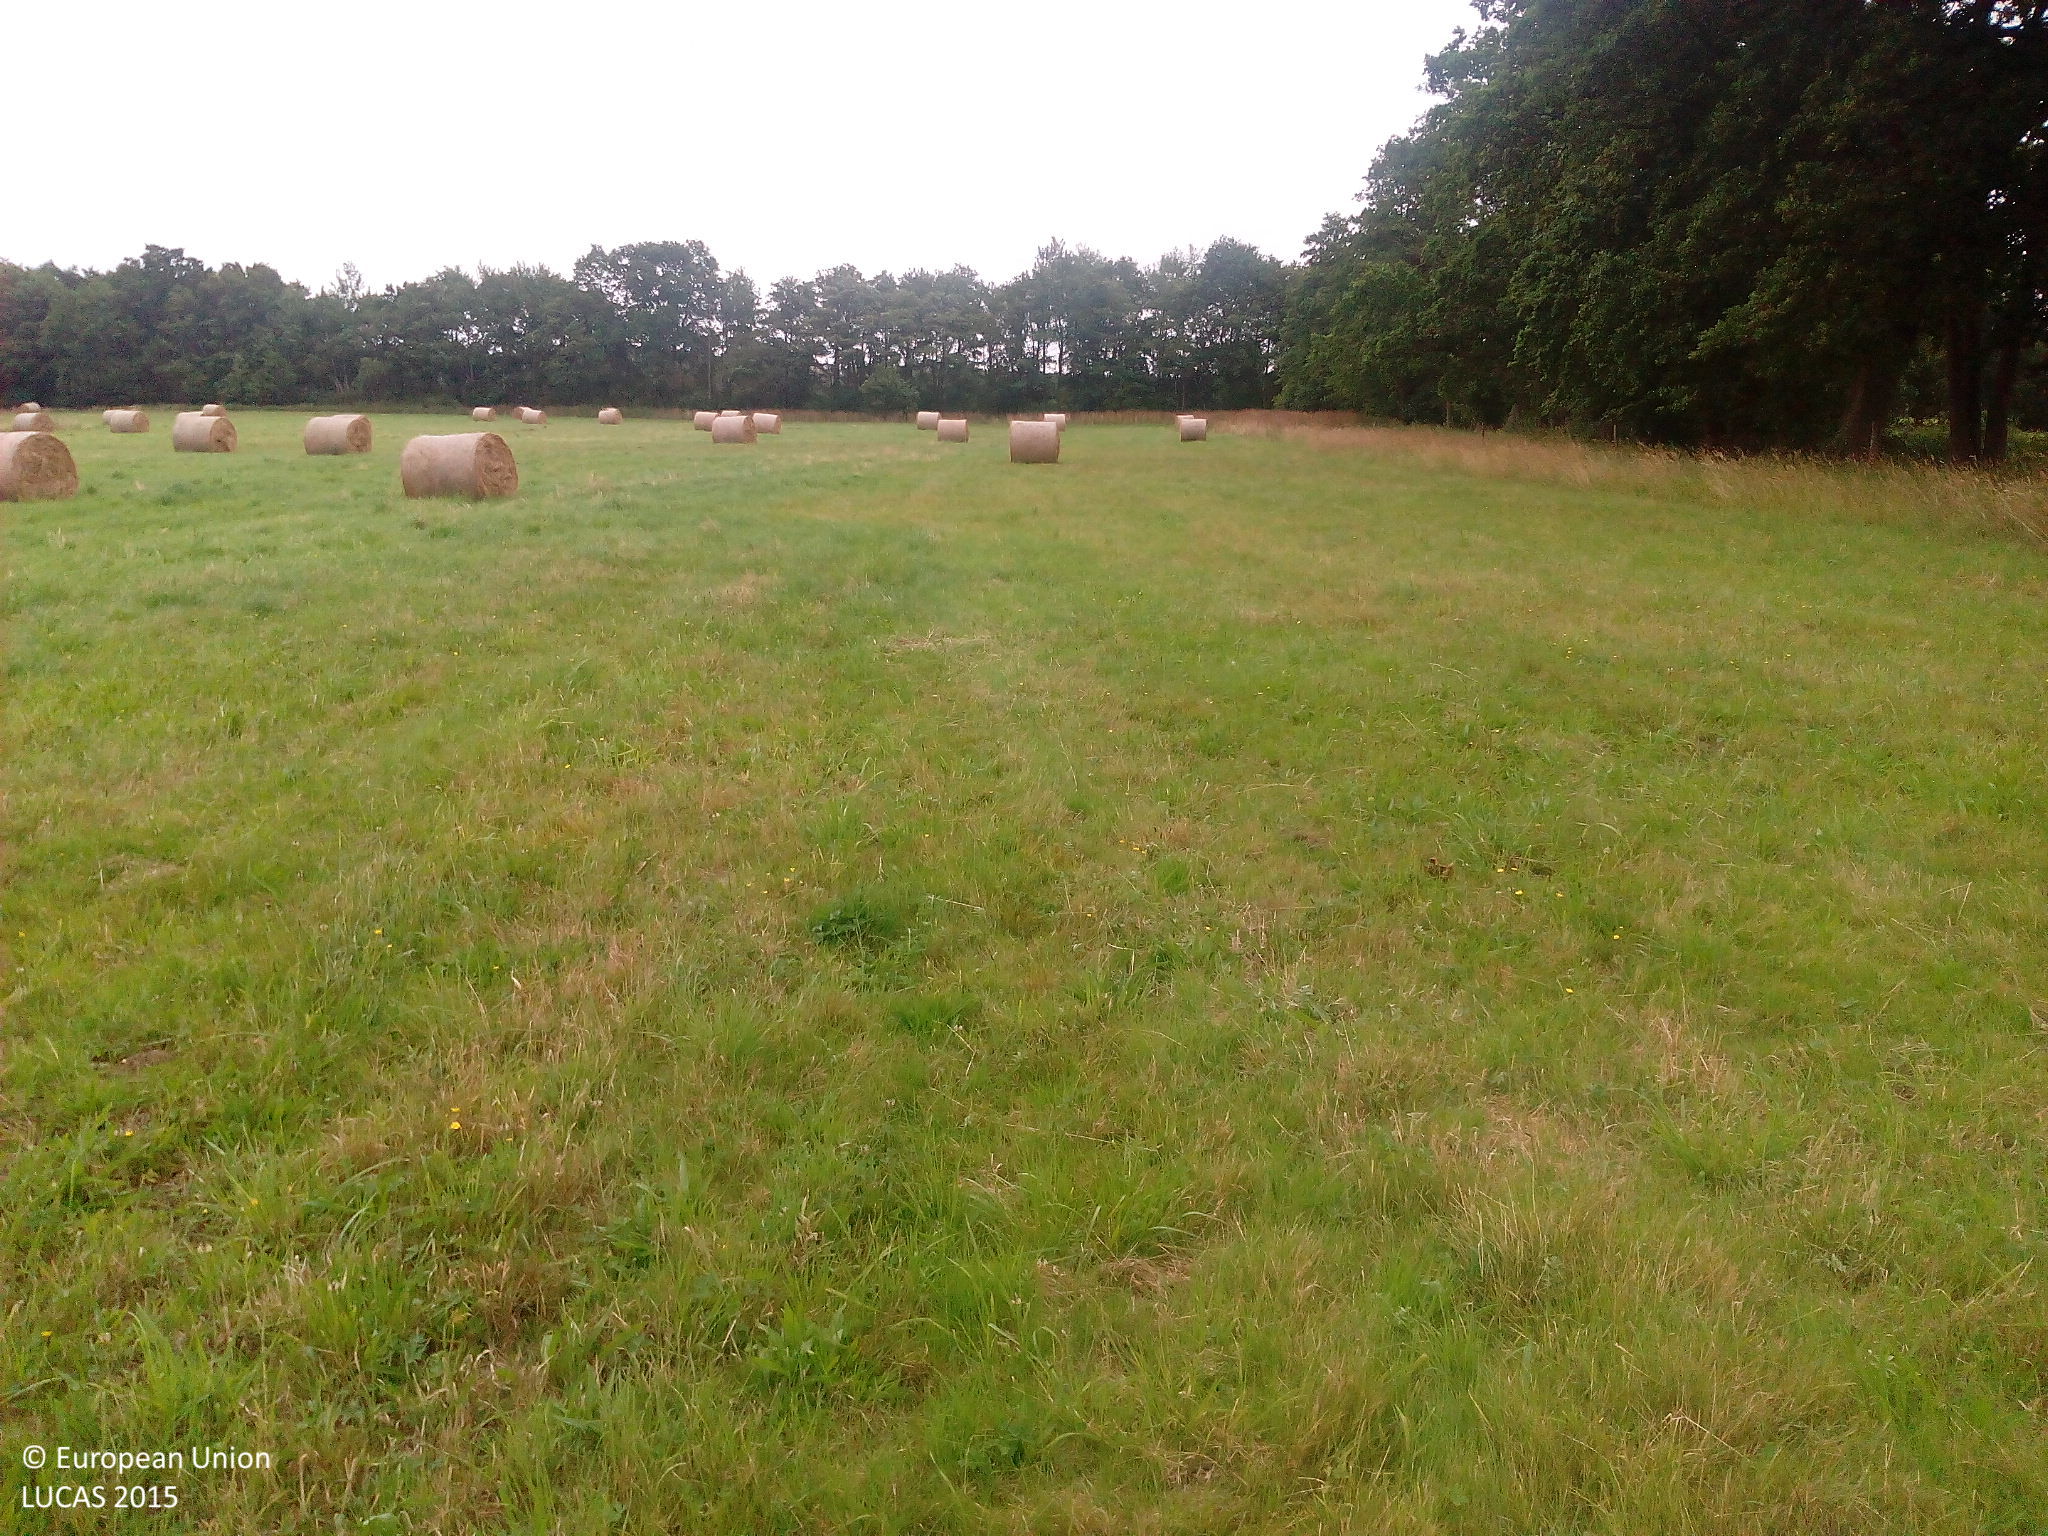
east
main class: Grassland
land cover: Grassland without tree/shrub cover
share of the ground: > 75 %
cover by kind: herbaceous plants 100 %
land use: Agriculture (excluding fallow land and kitchen gardens)
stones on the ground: < 10 %
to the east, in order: Grassland without tree/shrub cover; Spontaneously vegetated surfaces; Shruby margins; Ditches and canals; Broadleaved woodland; Tracks; Broadleaved woodland; Ditches and canals; Spontaneously vegetated surfaces; Grassland without tree/shrub cover
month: July
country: DE
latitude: 54.2788
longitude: 12.3181
